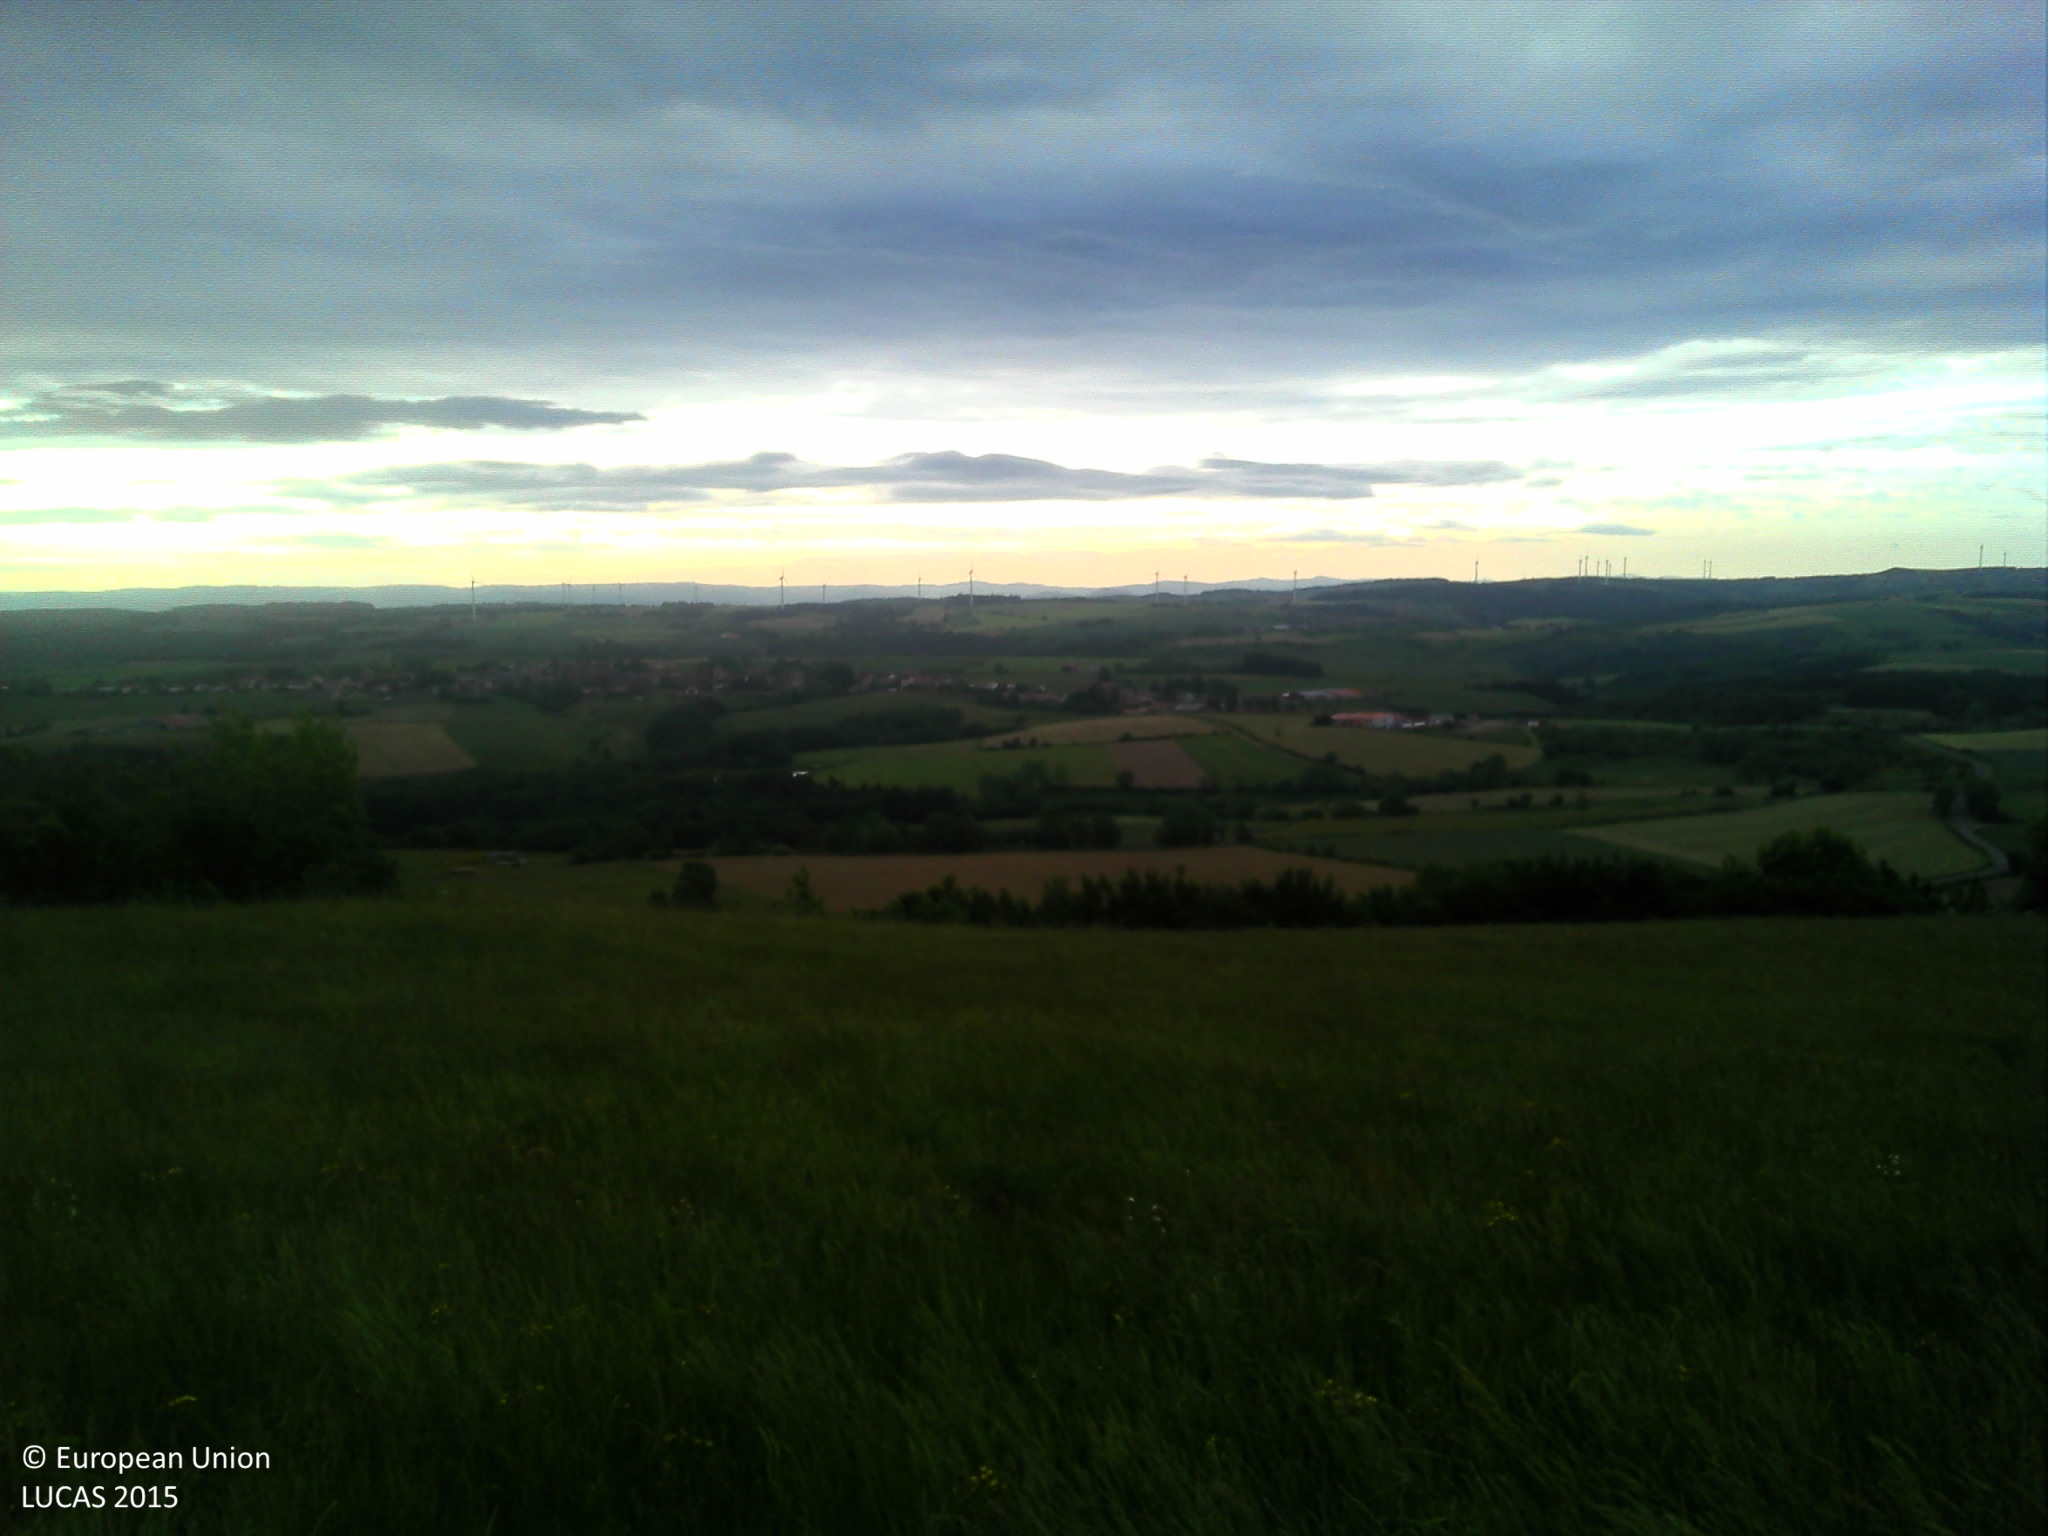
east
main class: Grassland
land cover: Grassland without tree/shrub cover
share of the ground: > 75 %
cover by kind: herbaceous plants 100 %
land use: Agriculture (excluding fallow land and kitchen gardens)
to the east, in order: Grassland without tree/shrub cover; Fences; Broadleaved woodland; Grassland without tree/shrub cover; Tracks; Grassland without tree/shrub cover; Fences; Broadleaved woodland; Grassland without tree/shrub cover; Fences; Grass margins; Ditches and canals; Grass margins; Paved roads, cycling and walking lanes; Grass margins; Ditches and canals; Shrubland without tree cover; Fences; Grassland without tree/shrub cover
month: June
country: FR
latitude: 45.1778
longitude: 3.2196
